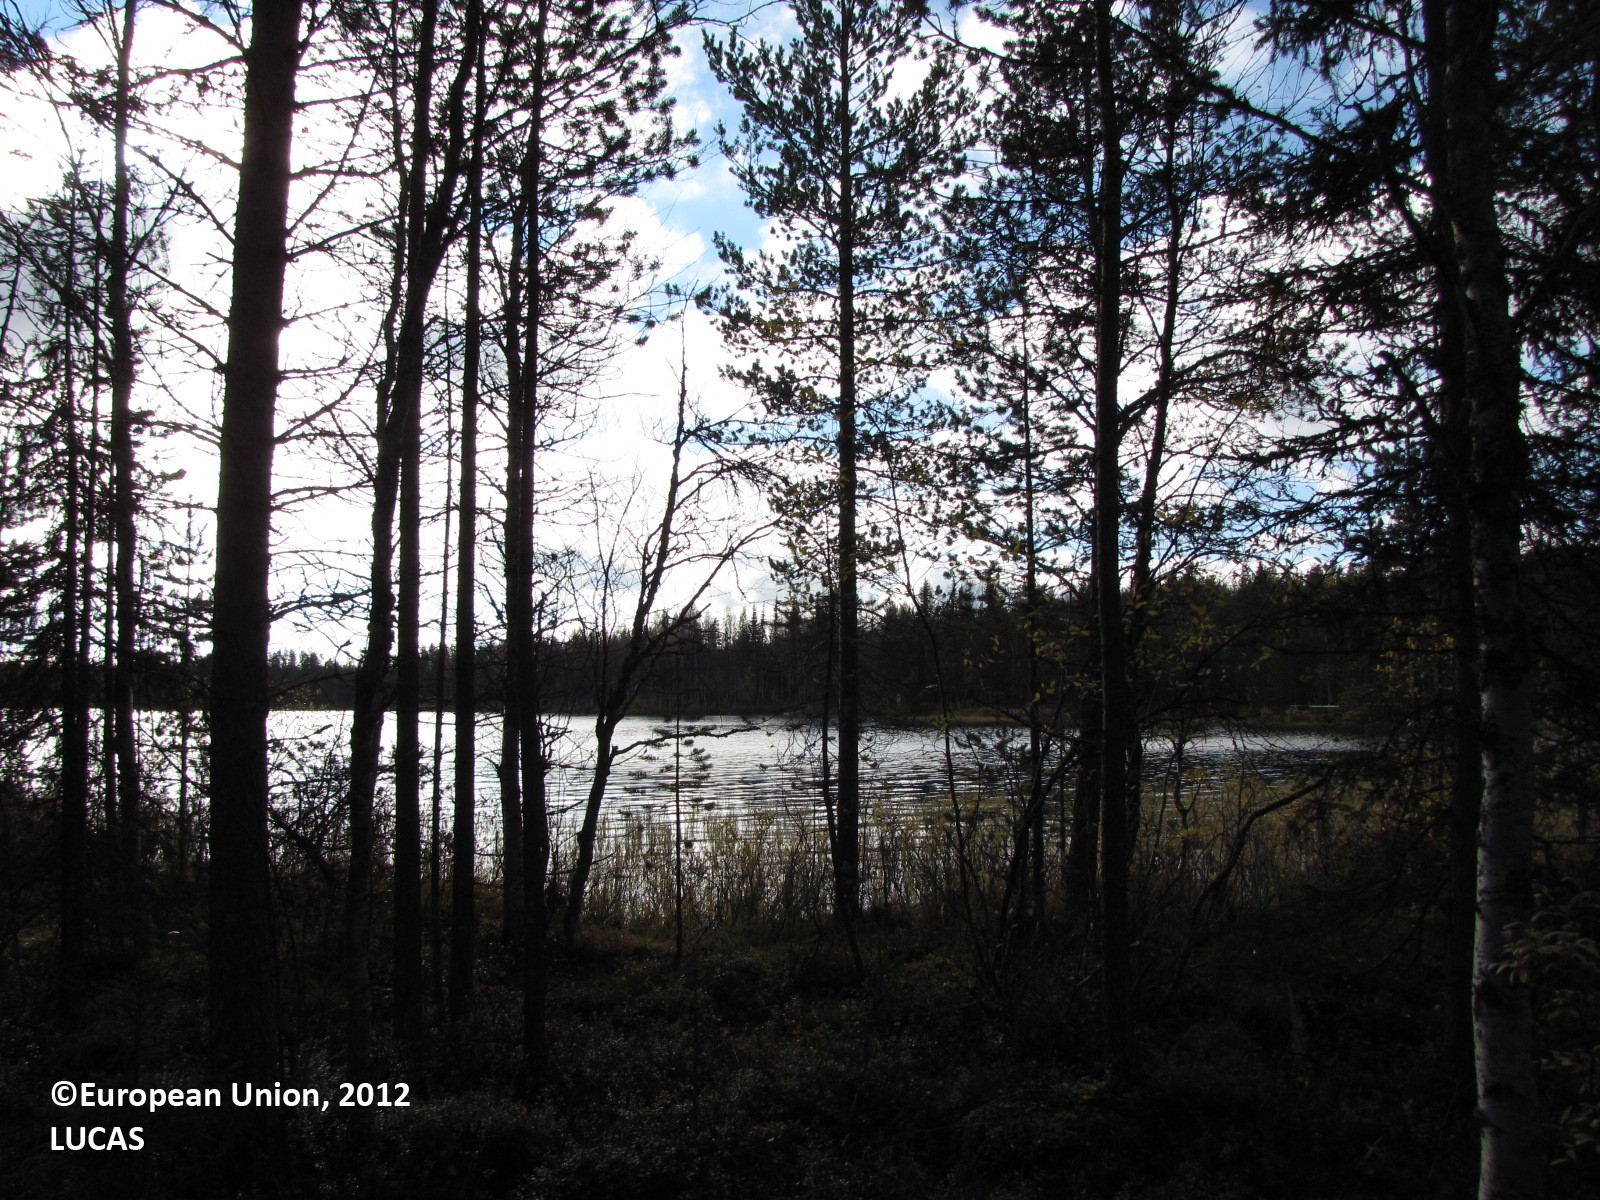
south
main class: Woodland
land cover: Pine dominated coniferous woodland
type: boreal forest
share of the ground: 25 - 50 %
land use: Forestry
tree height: > 5 m
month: September
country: FI
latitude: 67.8421
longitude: 23.6269
